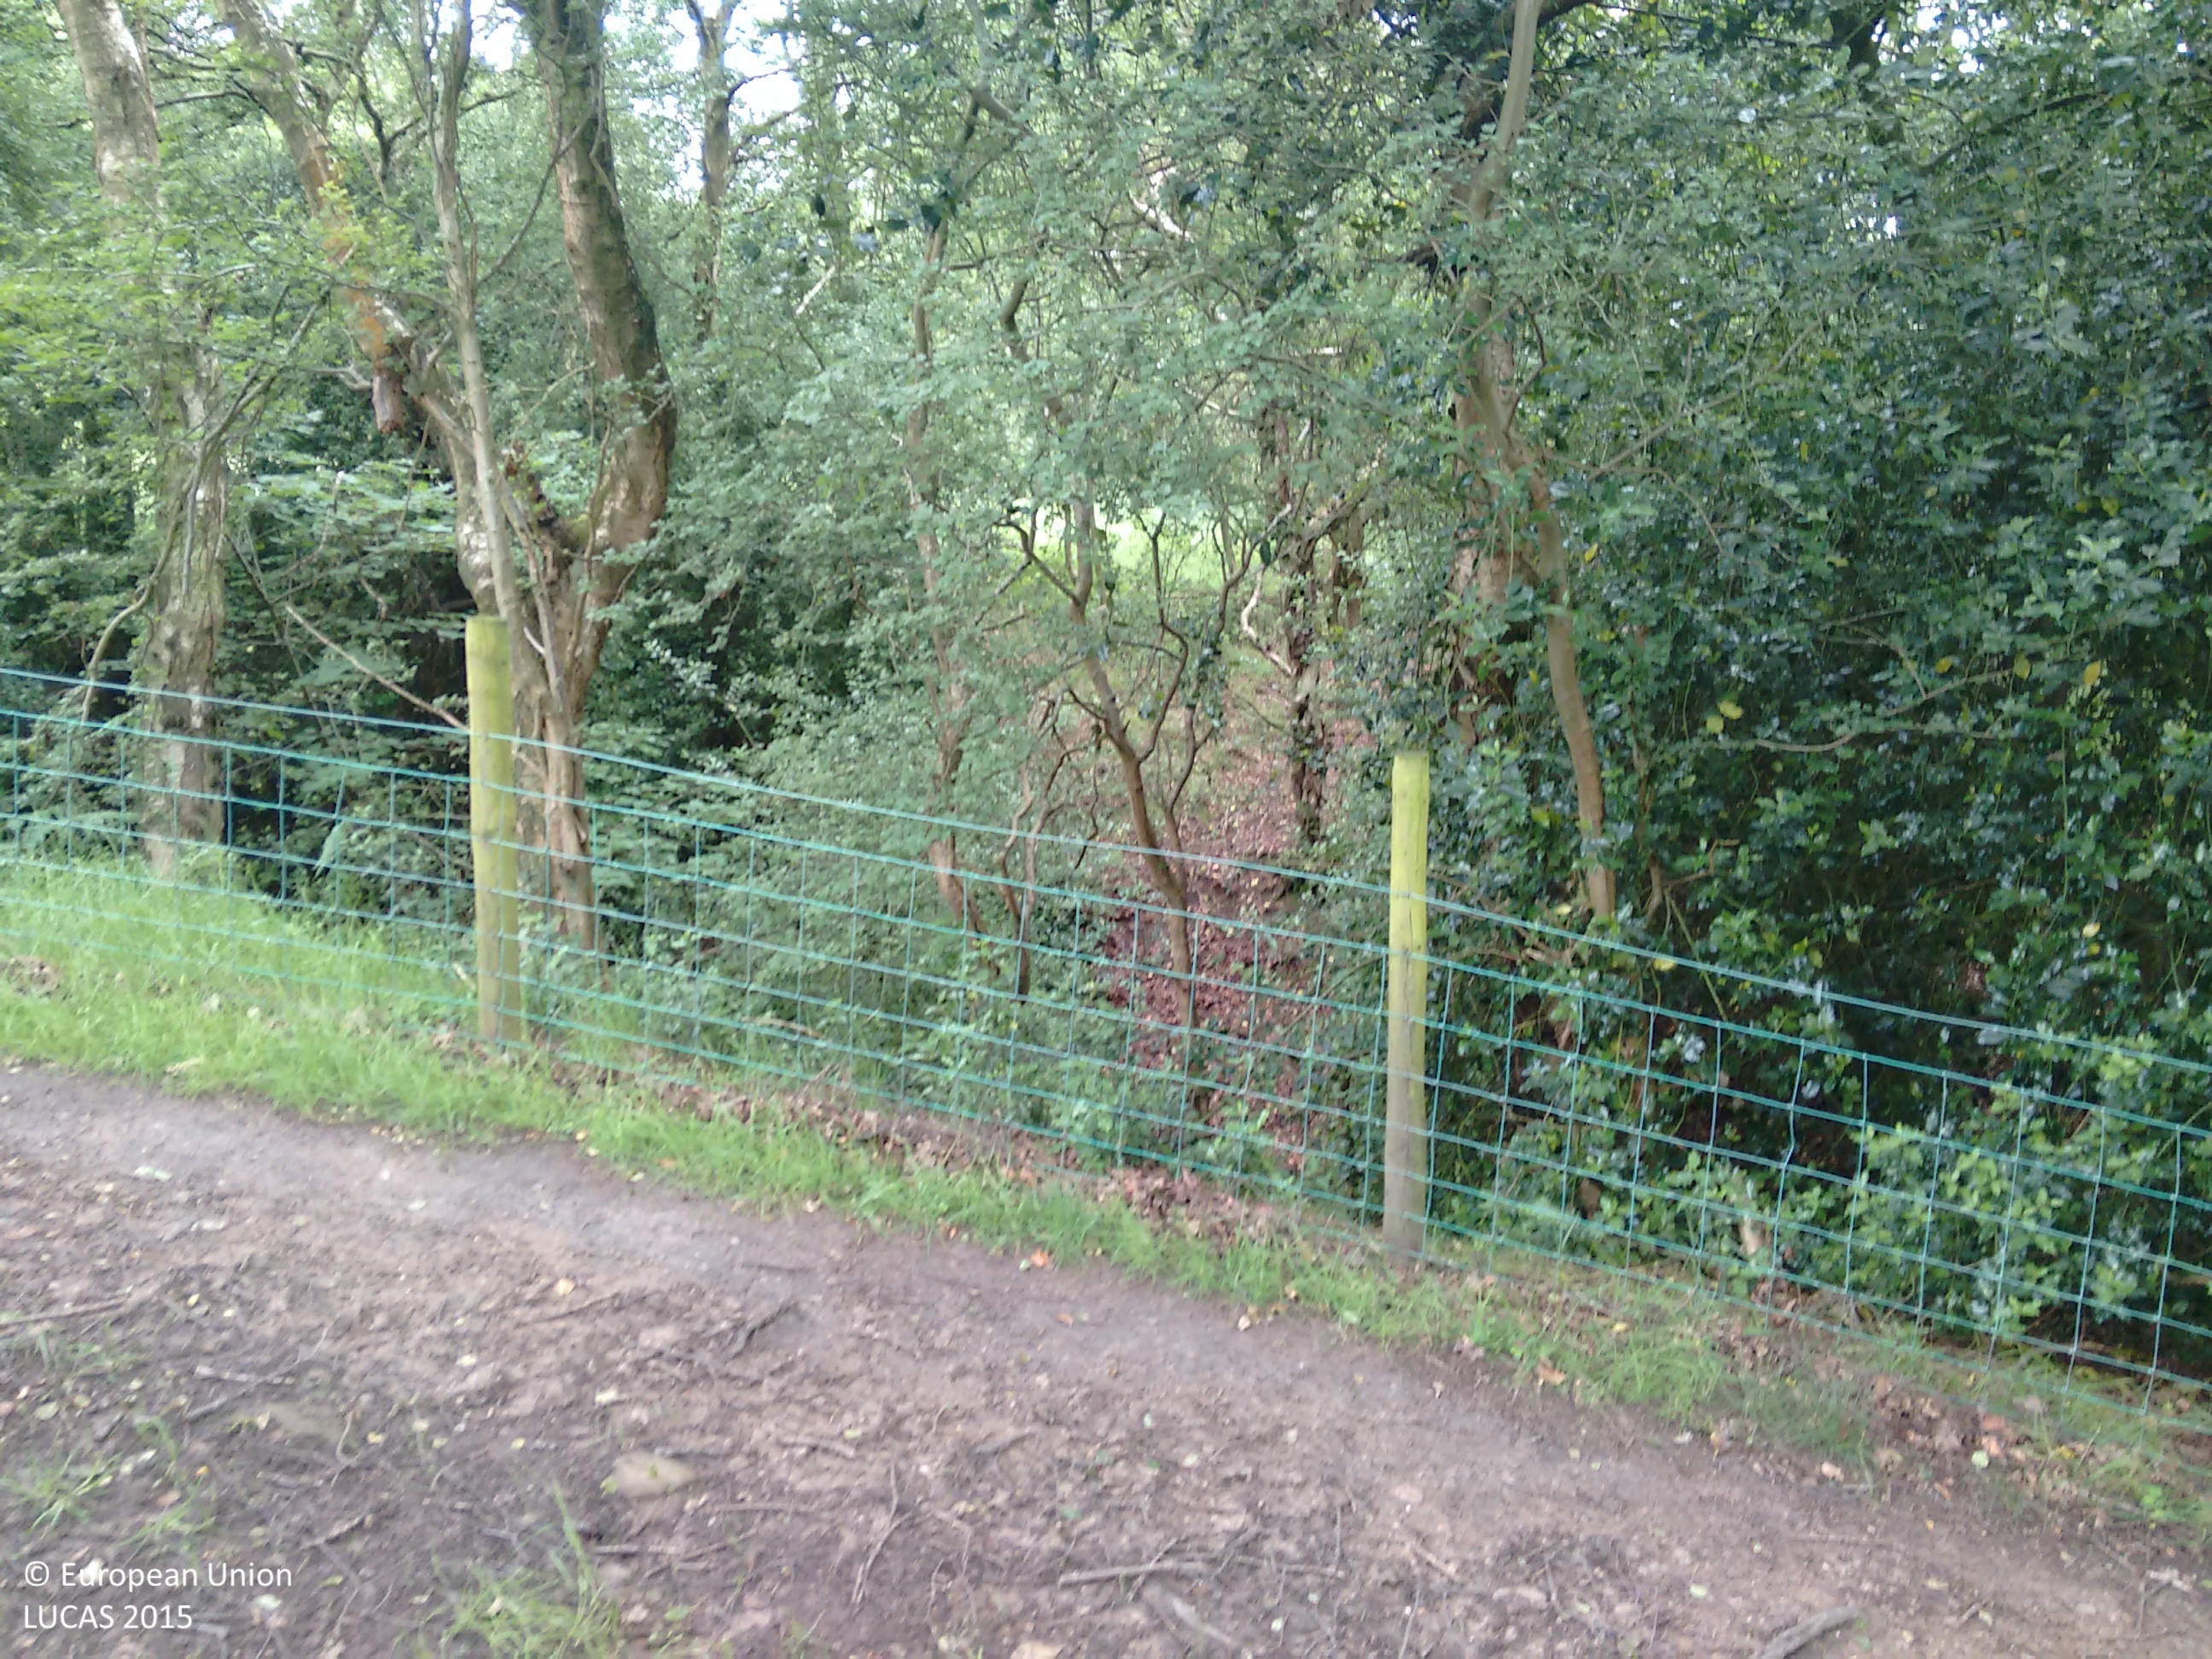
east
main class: Woodland
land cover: Broadleaved woodland
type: non-riverine alder, birch or aspen forest
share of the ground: > 75 %
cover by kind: broadleaved forest trees 100 %
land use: Agriculture (excluding fallow land and kitchen gardens)
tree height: > 5 m
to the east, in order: Broadleaved woodland; Tracks; Fences; Rivers and streams; Broadleaved woodland; Spontaneously vegetated surfaces; Broadleaved woodland; Lichens and moss; Broadleaved woodland; Spontaneously vegetated surfaces
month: July
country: GB
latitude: 53.3039
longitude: -2.0789
